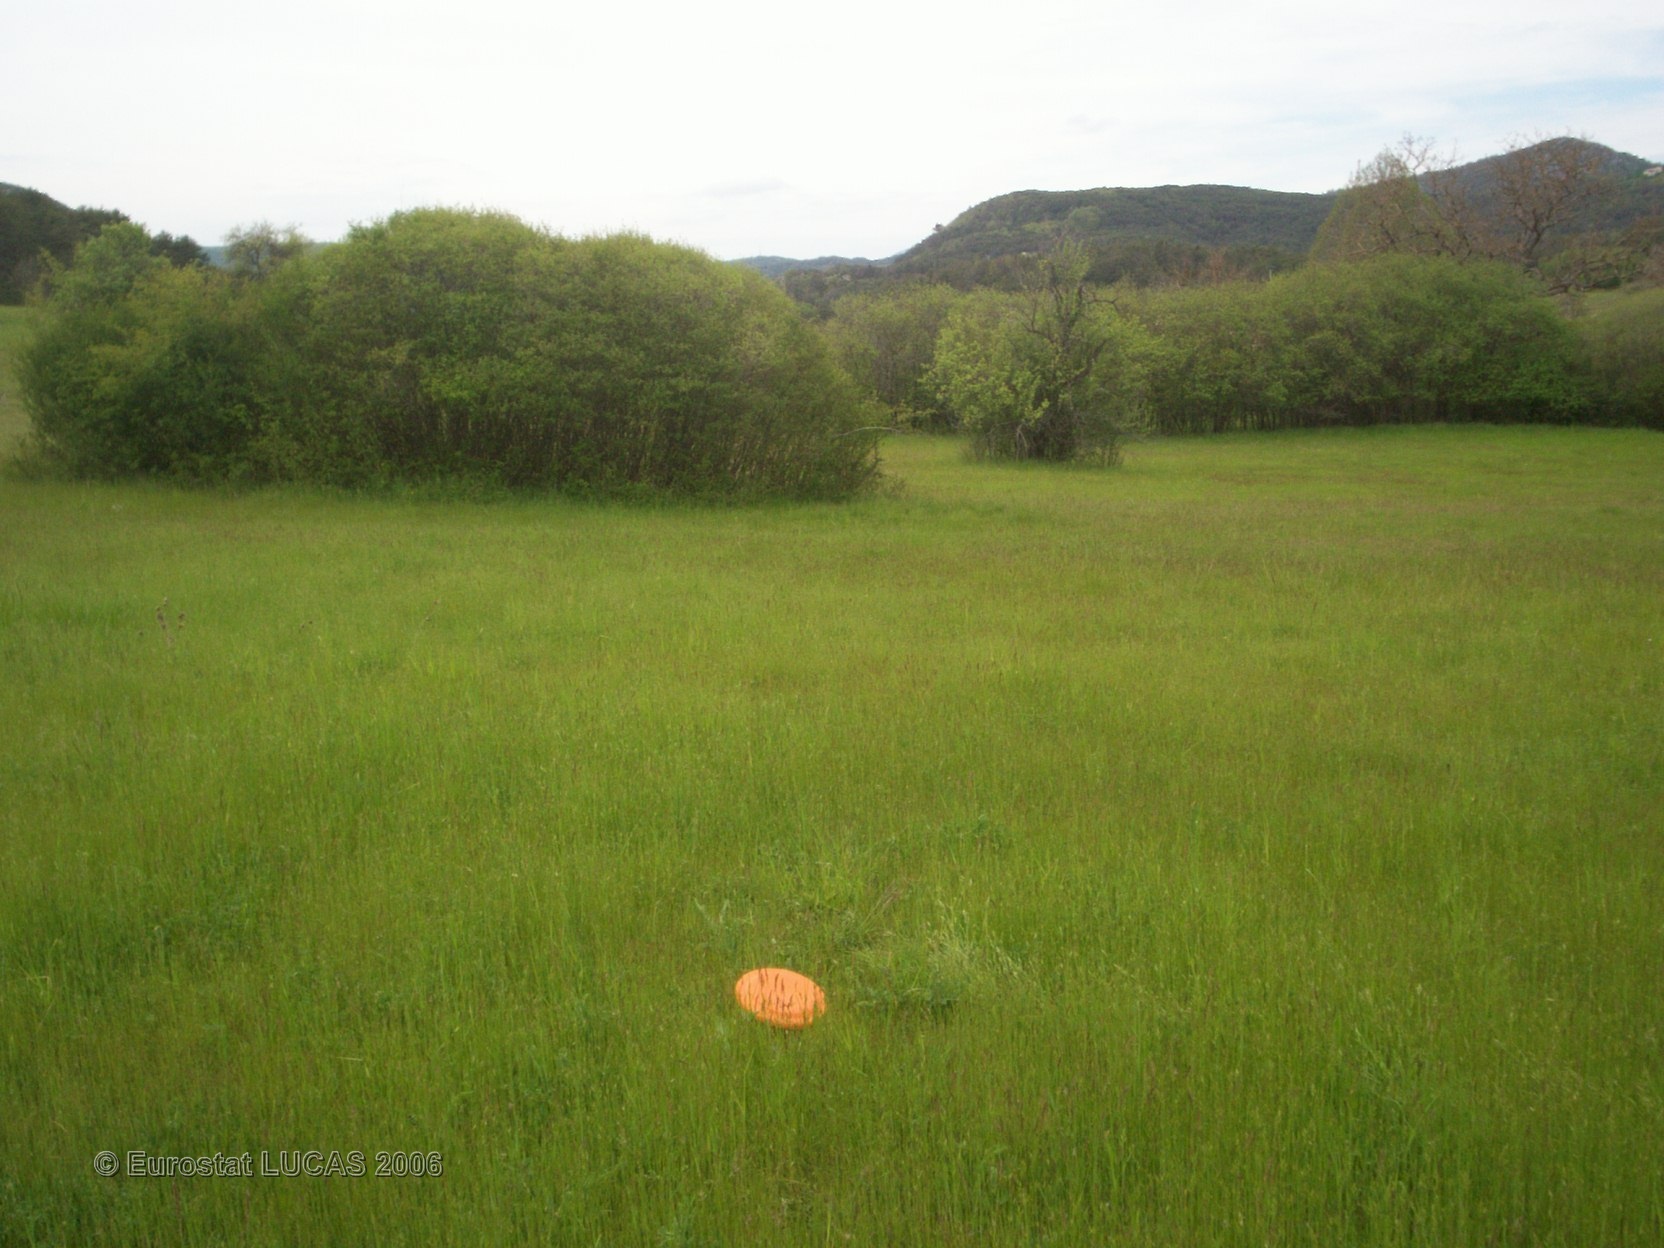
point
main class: Grassland
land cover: Grassland without tree/shrub cover
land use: Agriculture (excluding fallow land and kitchen gardens)
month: May
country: FR
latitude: 43.7153
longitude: 6.5451
